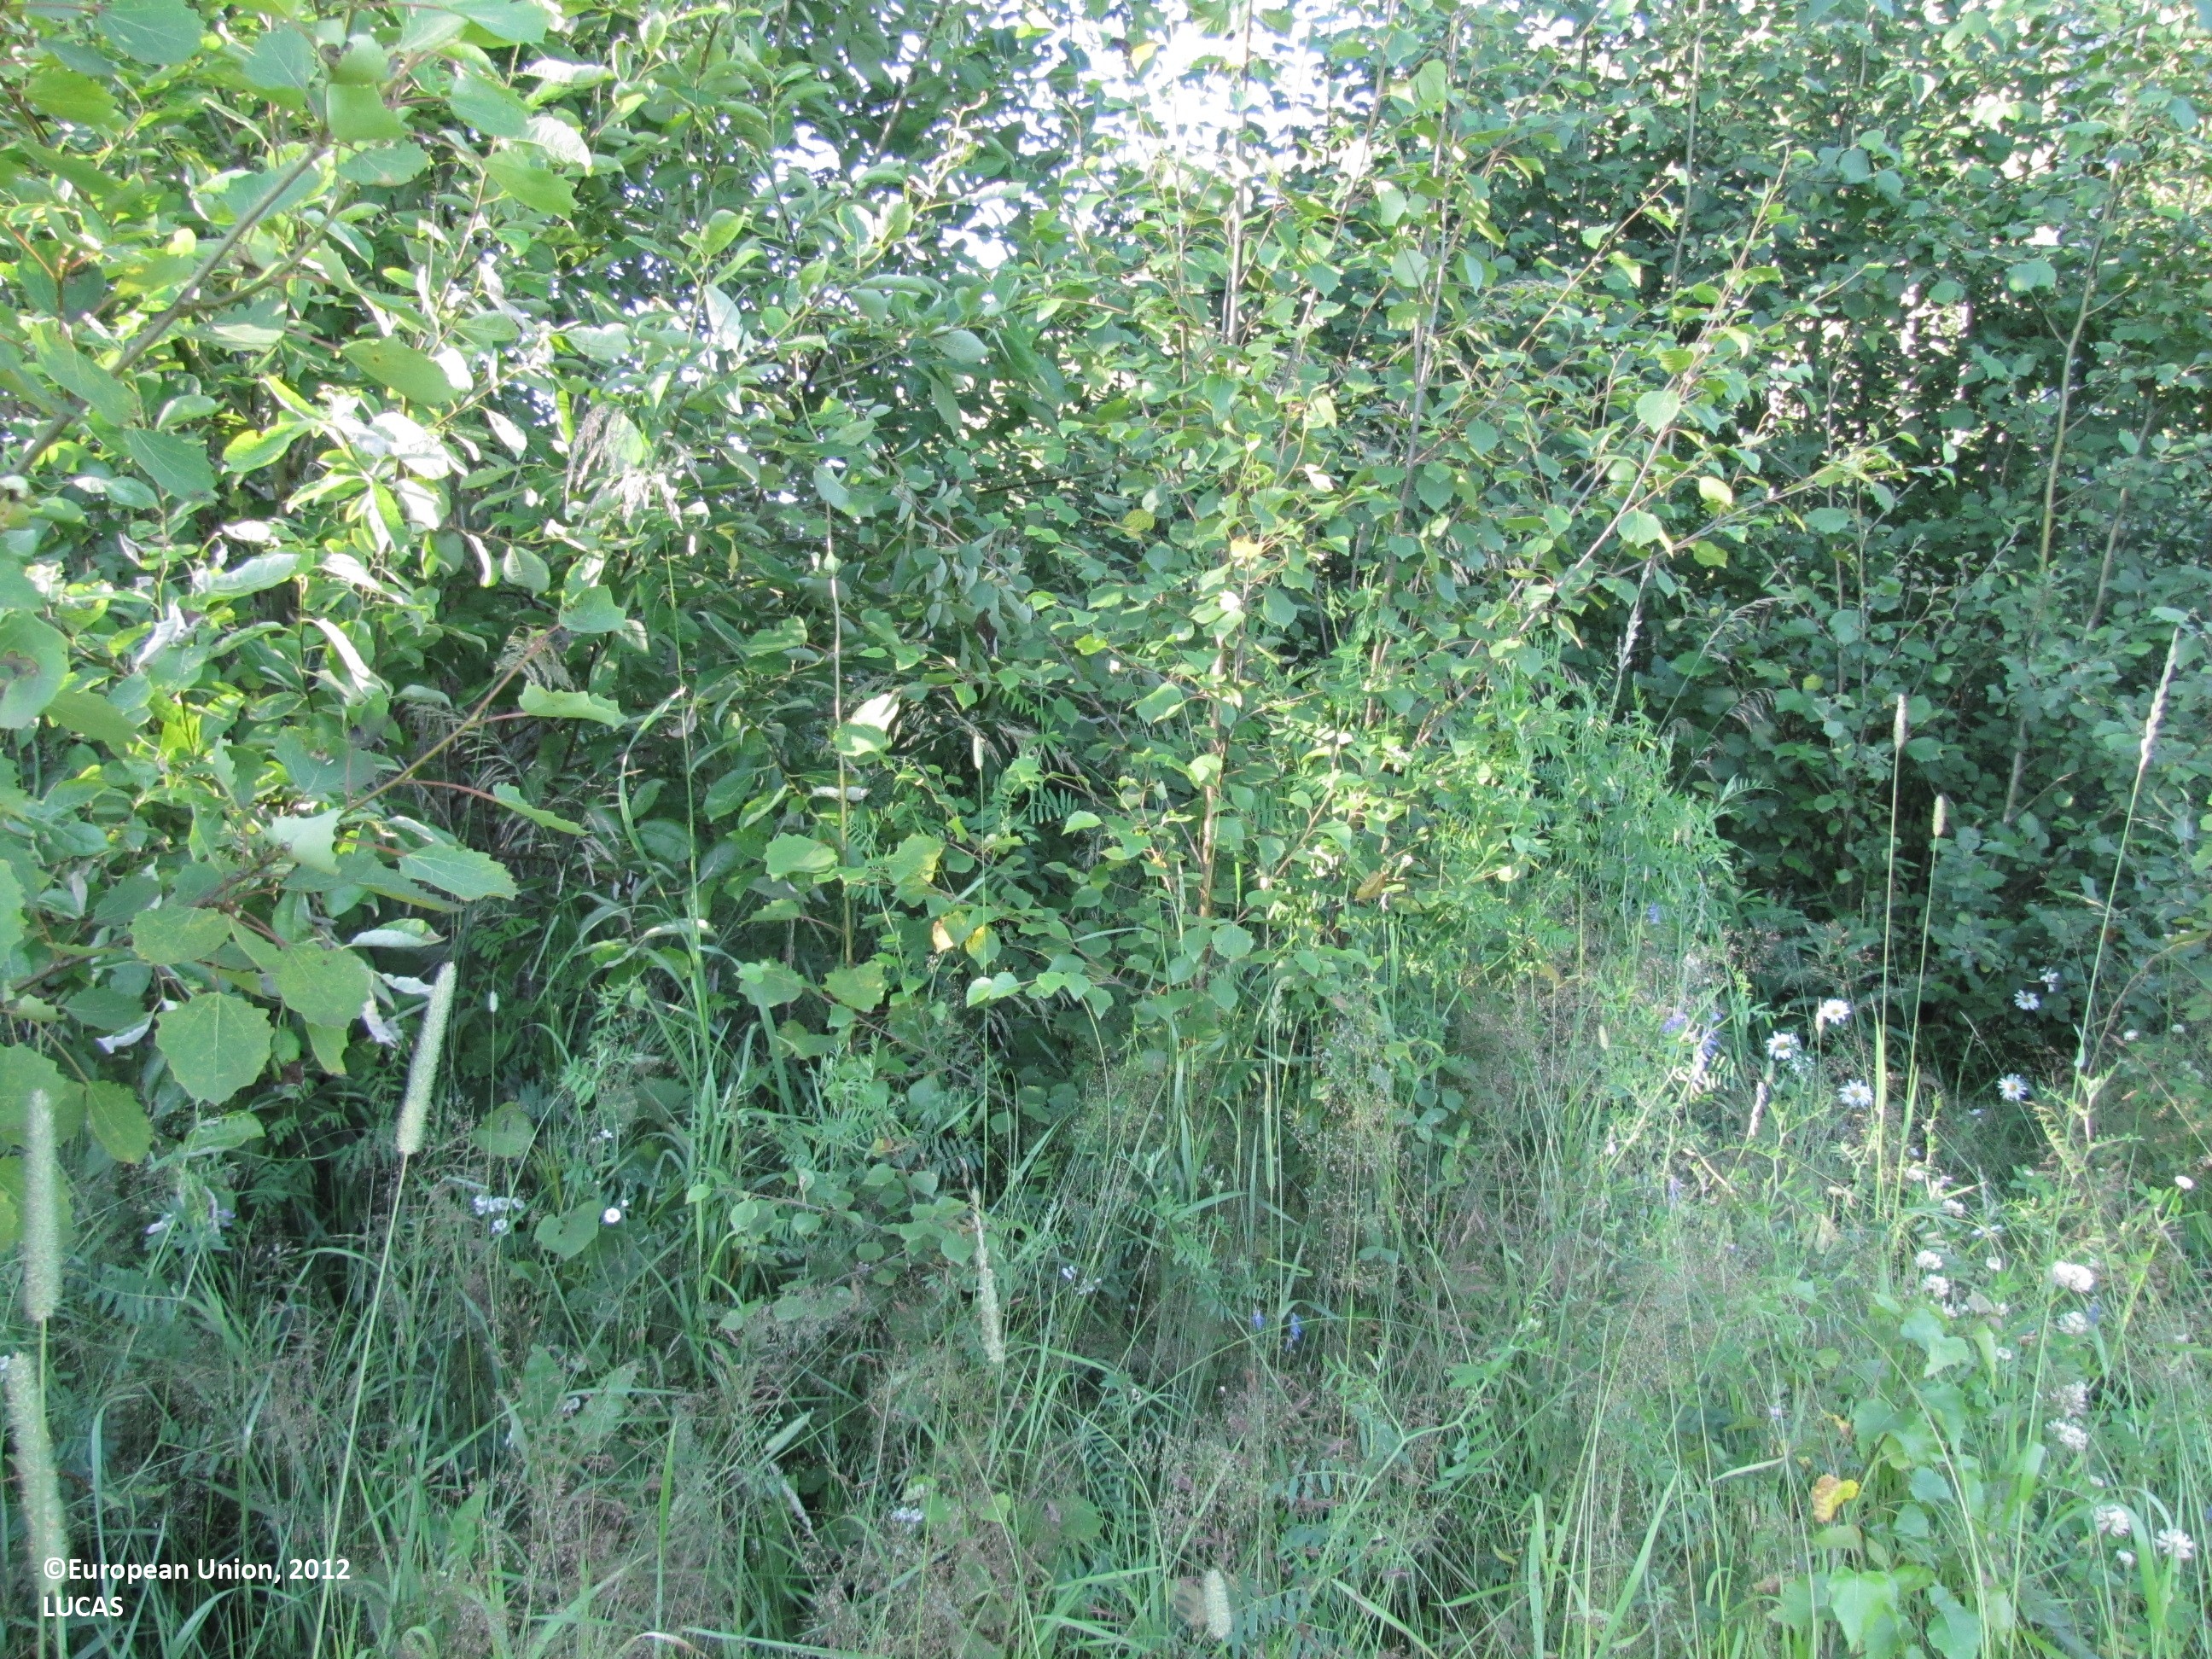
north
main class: Cropland
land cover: Other leguminous and mixtures for fodder
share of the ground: > 75 %
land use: Agriculture (excluding fallow land and kitchen gardens)
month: July
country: FI
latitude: 62.1153
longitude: 23.0424
